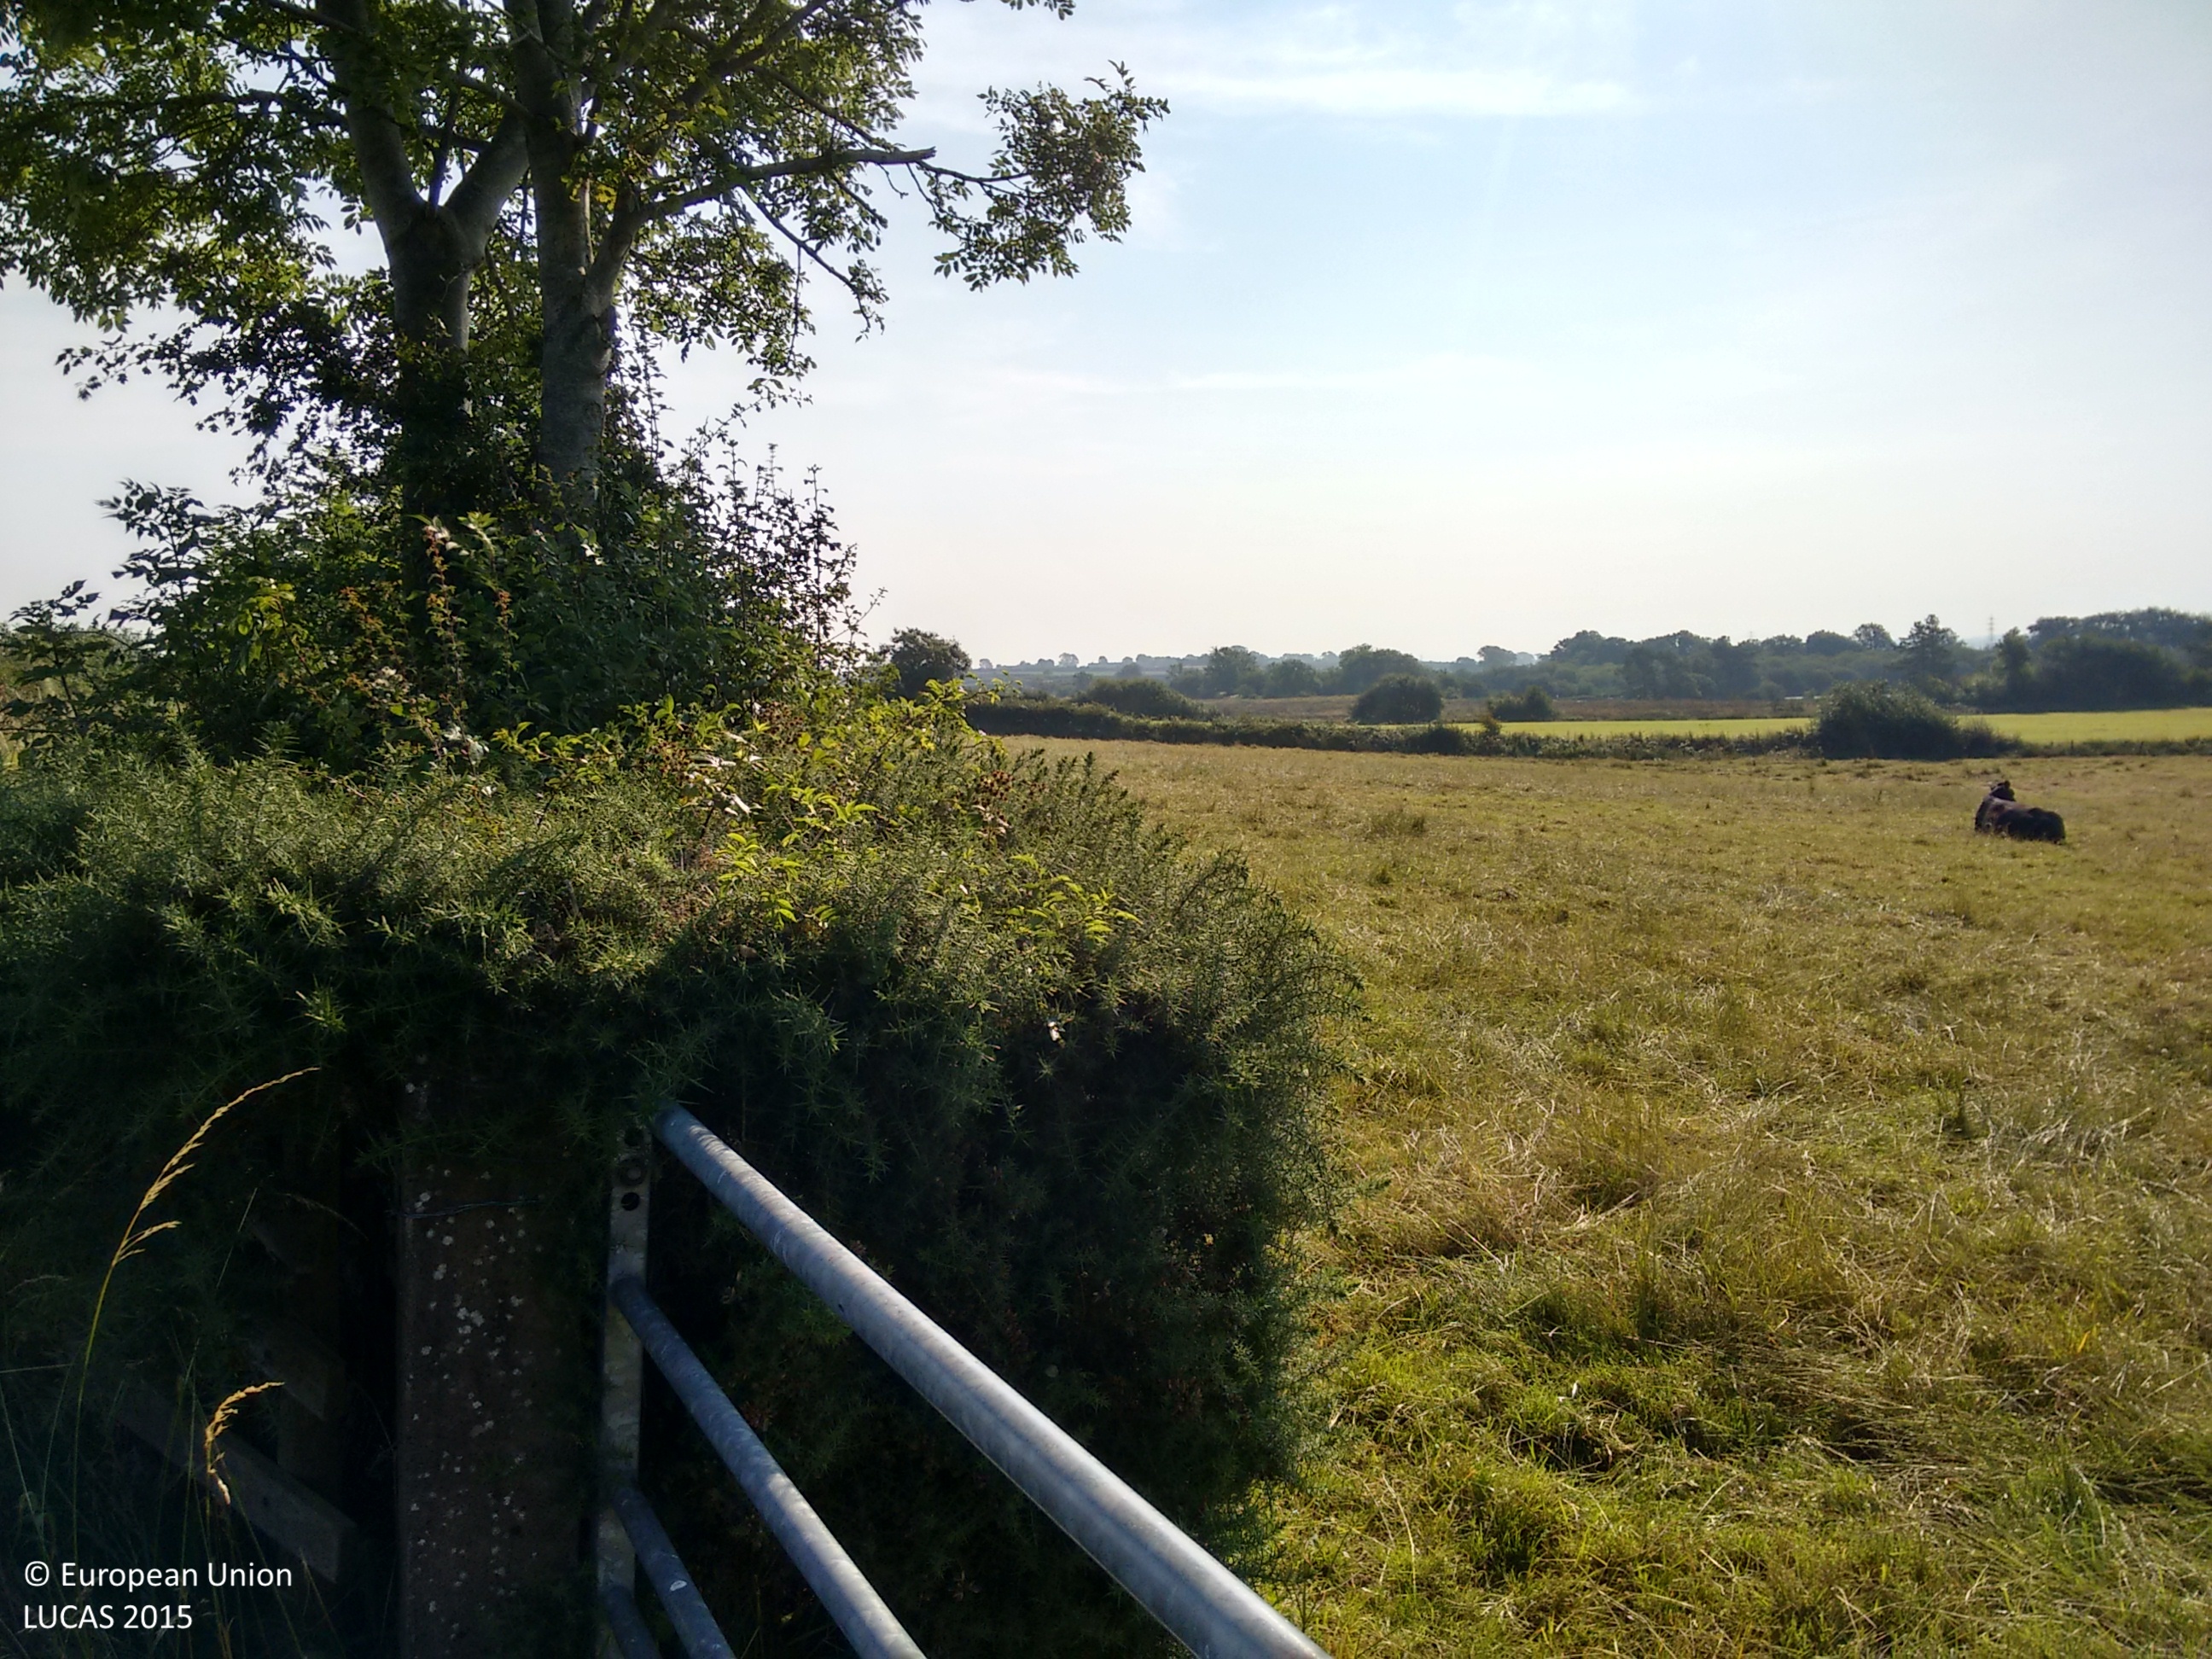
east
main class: Cropland
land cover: Temporary grasslands
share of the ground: > 75 %
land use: Agriculture (excluding fallow land and kitchen gardens)
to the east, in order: Temporary grasslands; Fences; Grassland without tree/shrub cover; Broadleaved woodland; Grassland with sparse tree/shrub cover; Broadleaved woodland
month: August
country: GB
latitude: 54.8448
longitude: -3.2033
